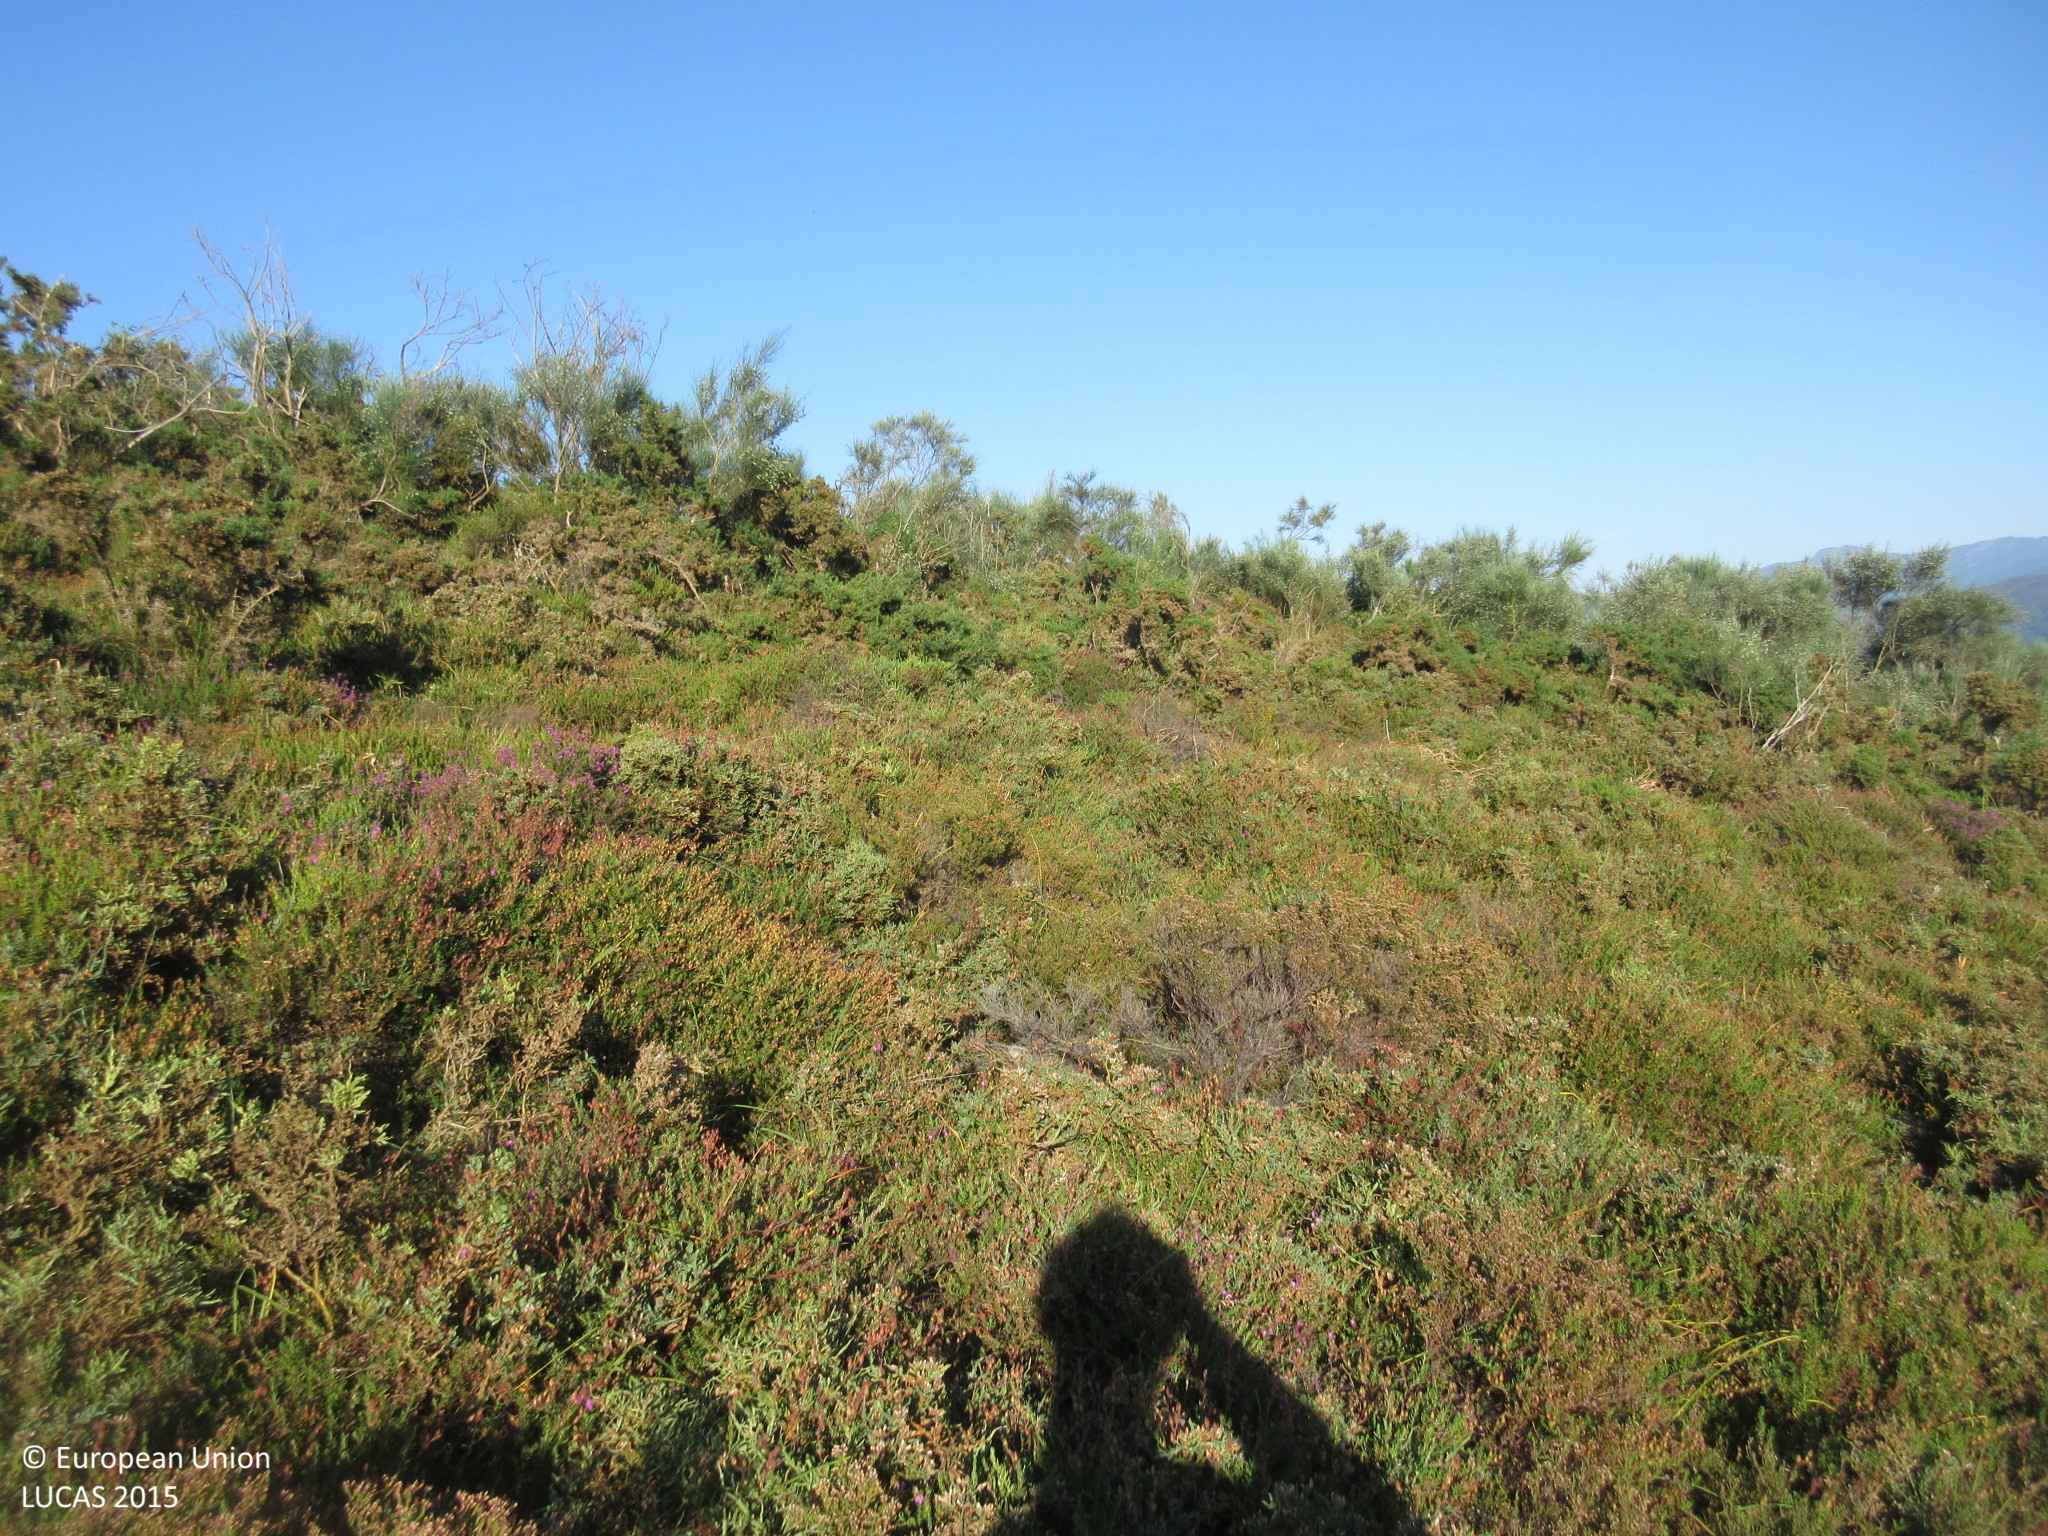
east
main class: Woodland
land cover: Broadleaved woodland
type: acidophilous oak and oak-birch forest
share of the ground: 50 - 75 %
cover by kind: broadleaved forest trees 70 %, shrubs 30 %
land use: Forestry
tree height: > 5 m
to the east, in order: Broadleaved woodland; Shrubland with sparse tree cover; Grassland without tree/shrub cover; Broadleaved woodland
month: June
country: ES
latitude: 43.0121
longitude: -6.9809
